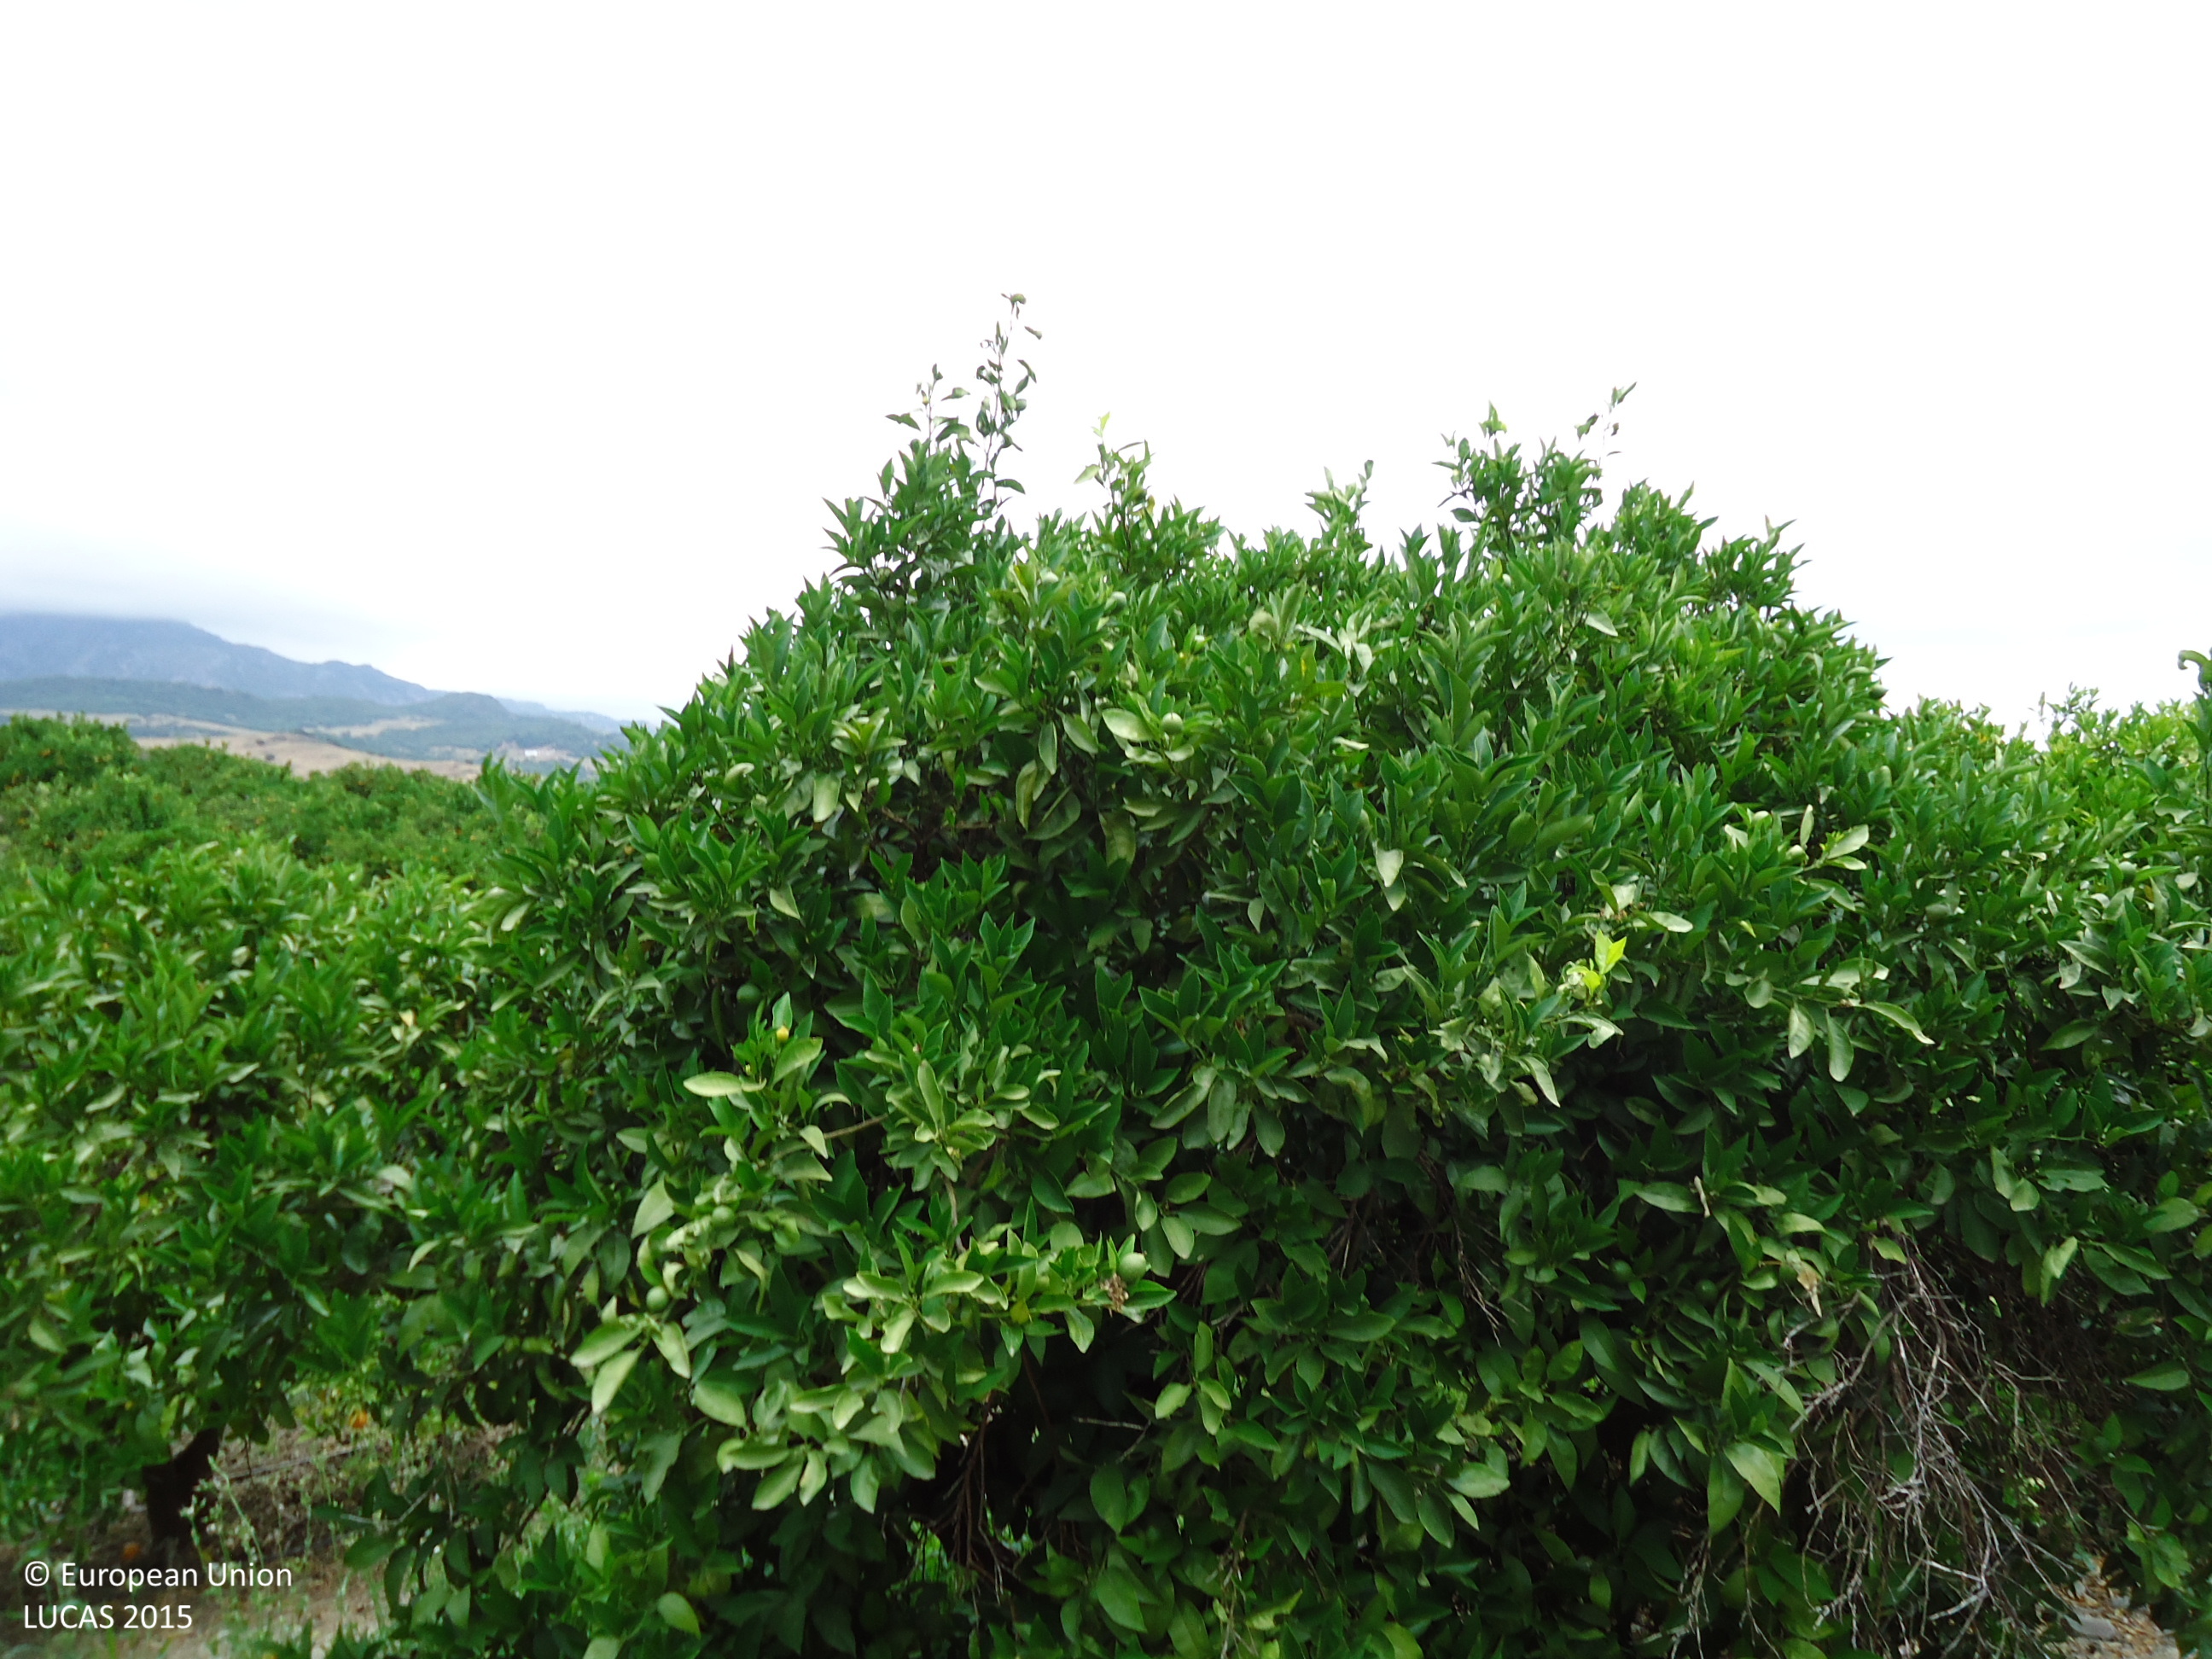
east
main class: Cropland
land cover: Oranges
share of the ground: > 75 %
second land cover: Spontaneously vegetated surfaces
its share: > 75 %
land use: Agriculture (excluding fallow land and kitchen gardens)
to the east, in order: Oranges; Spontaneously vegetated surfaces; Rivers and streams; Oranges; Tracks; Fences; Abandoned hedges; Grassland without tree/shrub cover
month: June
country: ES
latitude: 36.4226
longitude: -5.3310
